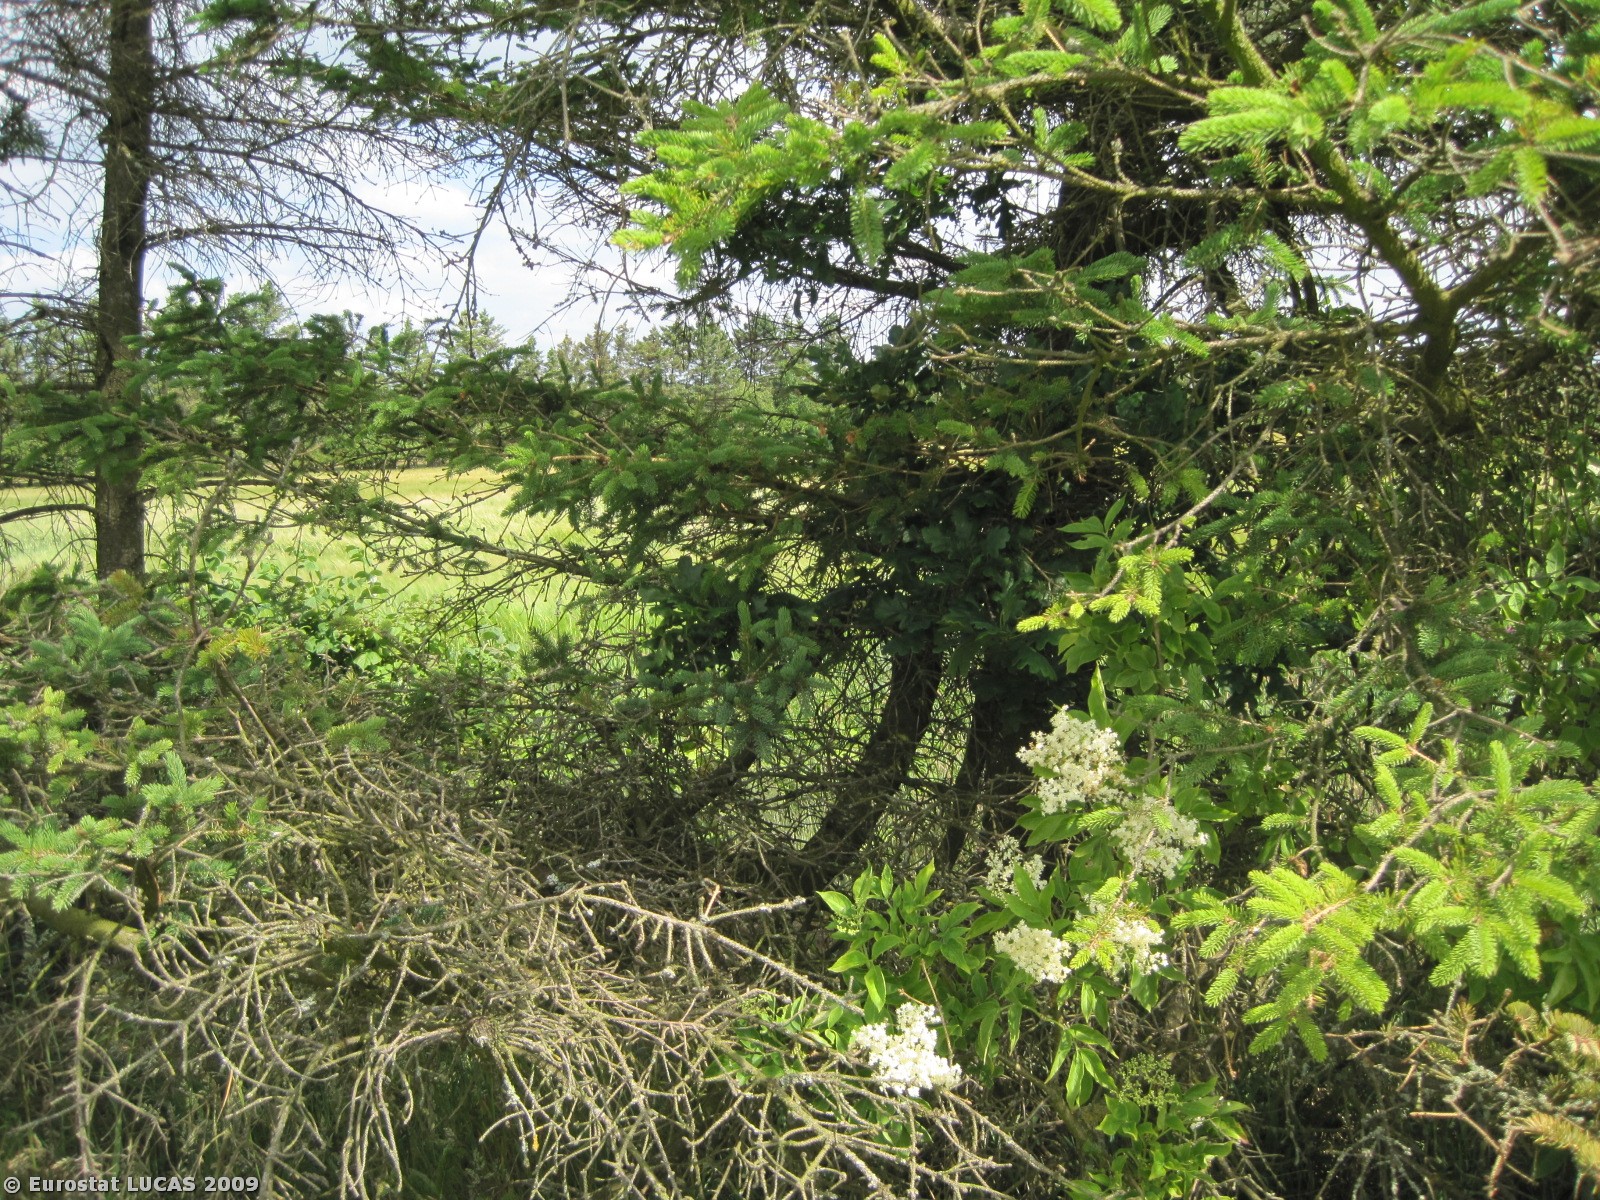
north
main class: Cropland
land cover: Barley
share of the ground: > 75 %
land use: Agriculture (excluding fallow land and kitchen gardens)
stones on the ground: < 10 %
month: June
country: DK
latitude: 56.3255
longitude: 8.7563
